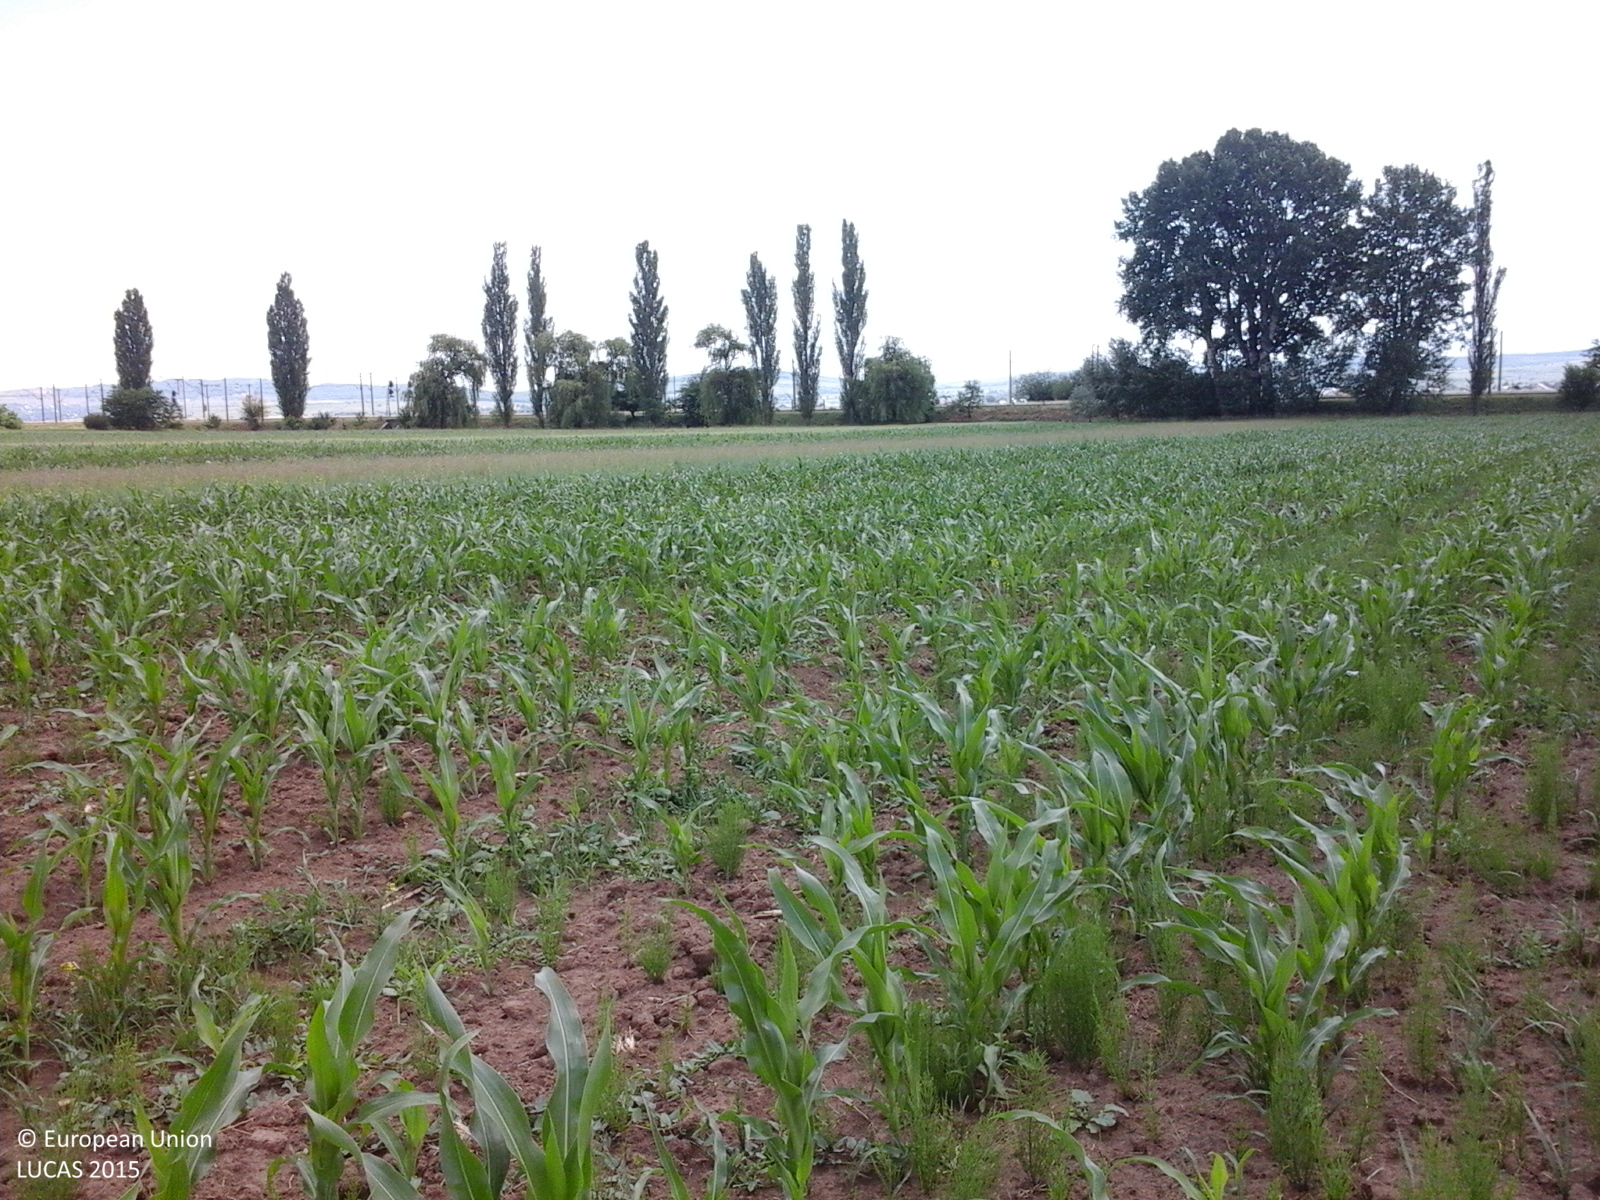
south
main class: Cropland
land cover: Maize
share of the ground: 50 - 75 %
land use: Agriculture (excluding fallow land and kitchen gardens)
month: June
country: RO
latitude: 47.6325
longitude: 26.3624
